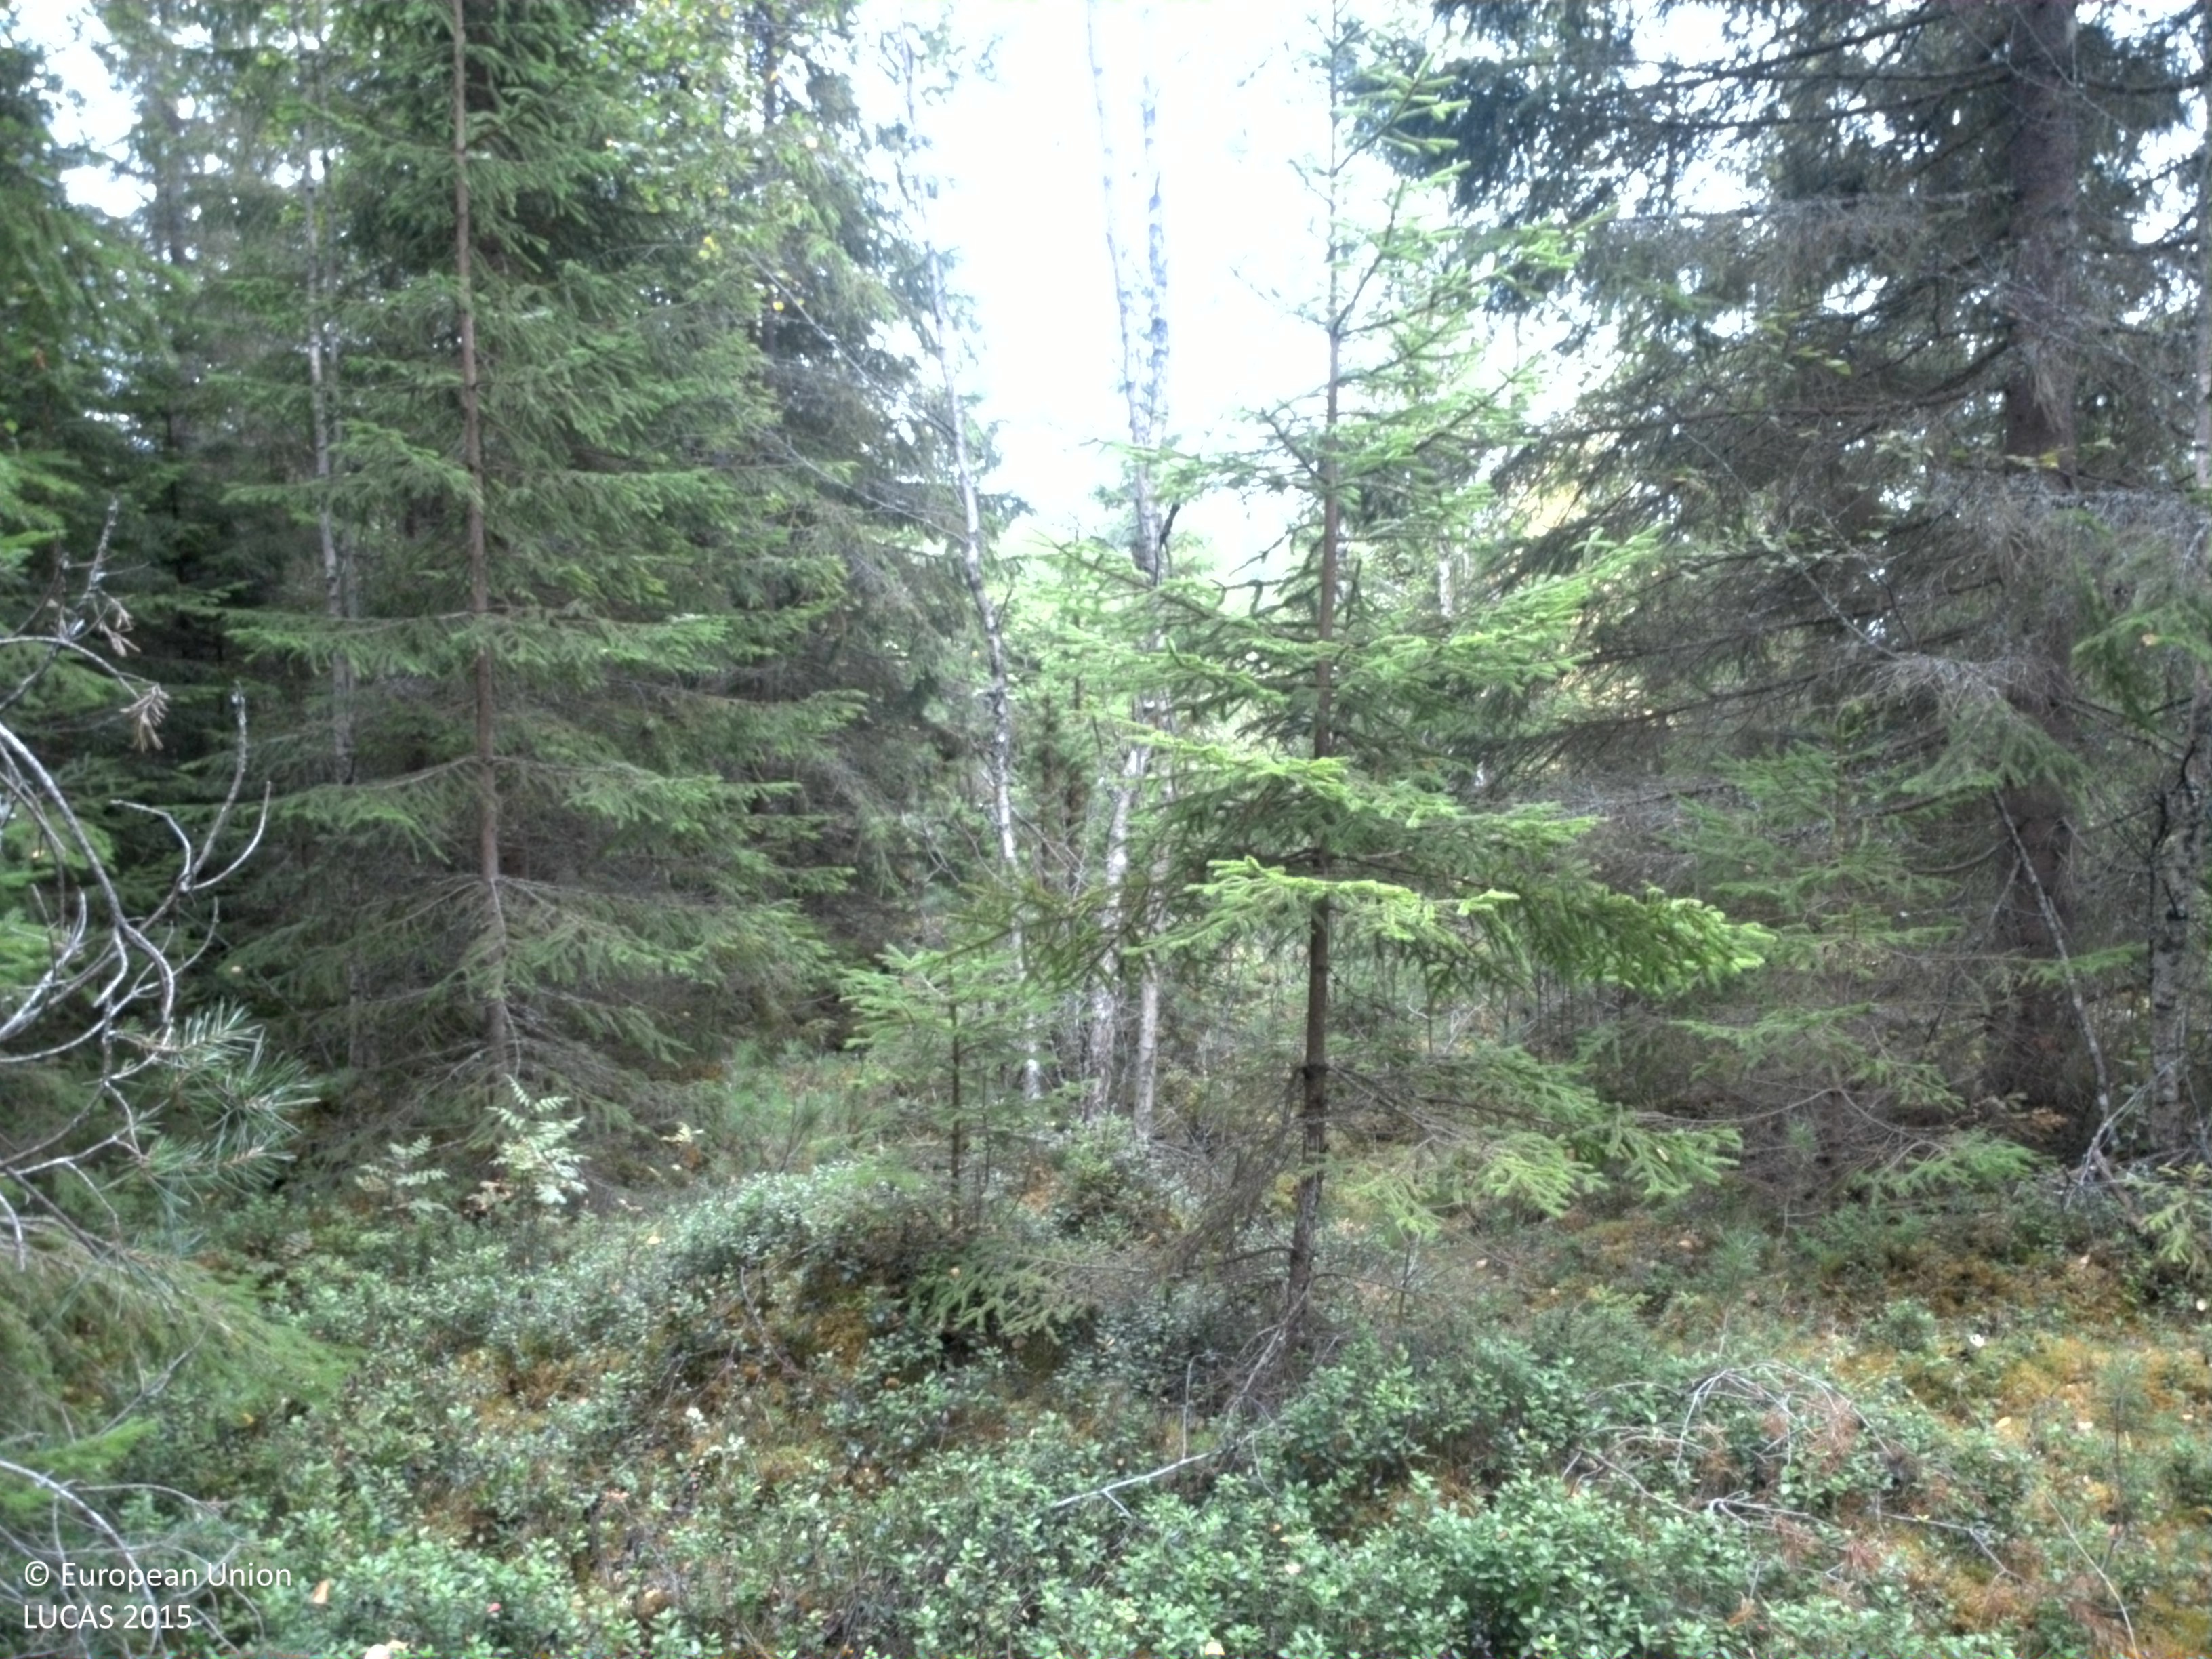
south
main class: Woodland
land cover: Spruce dominated coniferous woodland
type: boreal forest
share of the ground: 25 - 50 %
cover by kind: coniferous forest trees 40 %, shrubs 20 %, lichens and mosses 20 %, broadleaved forest trees 10 %, herbaceous plants 10 %
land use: Forestry
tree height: > 5 m
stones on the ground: 10 - 25 %
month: August
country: SE
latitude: 59.6528
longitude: 13.4164
